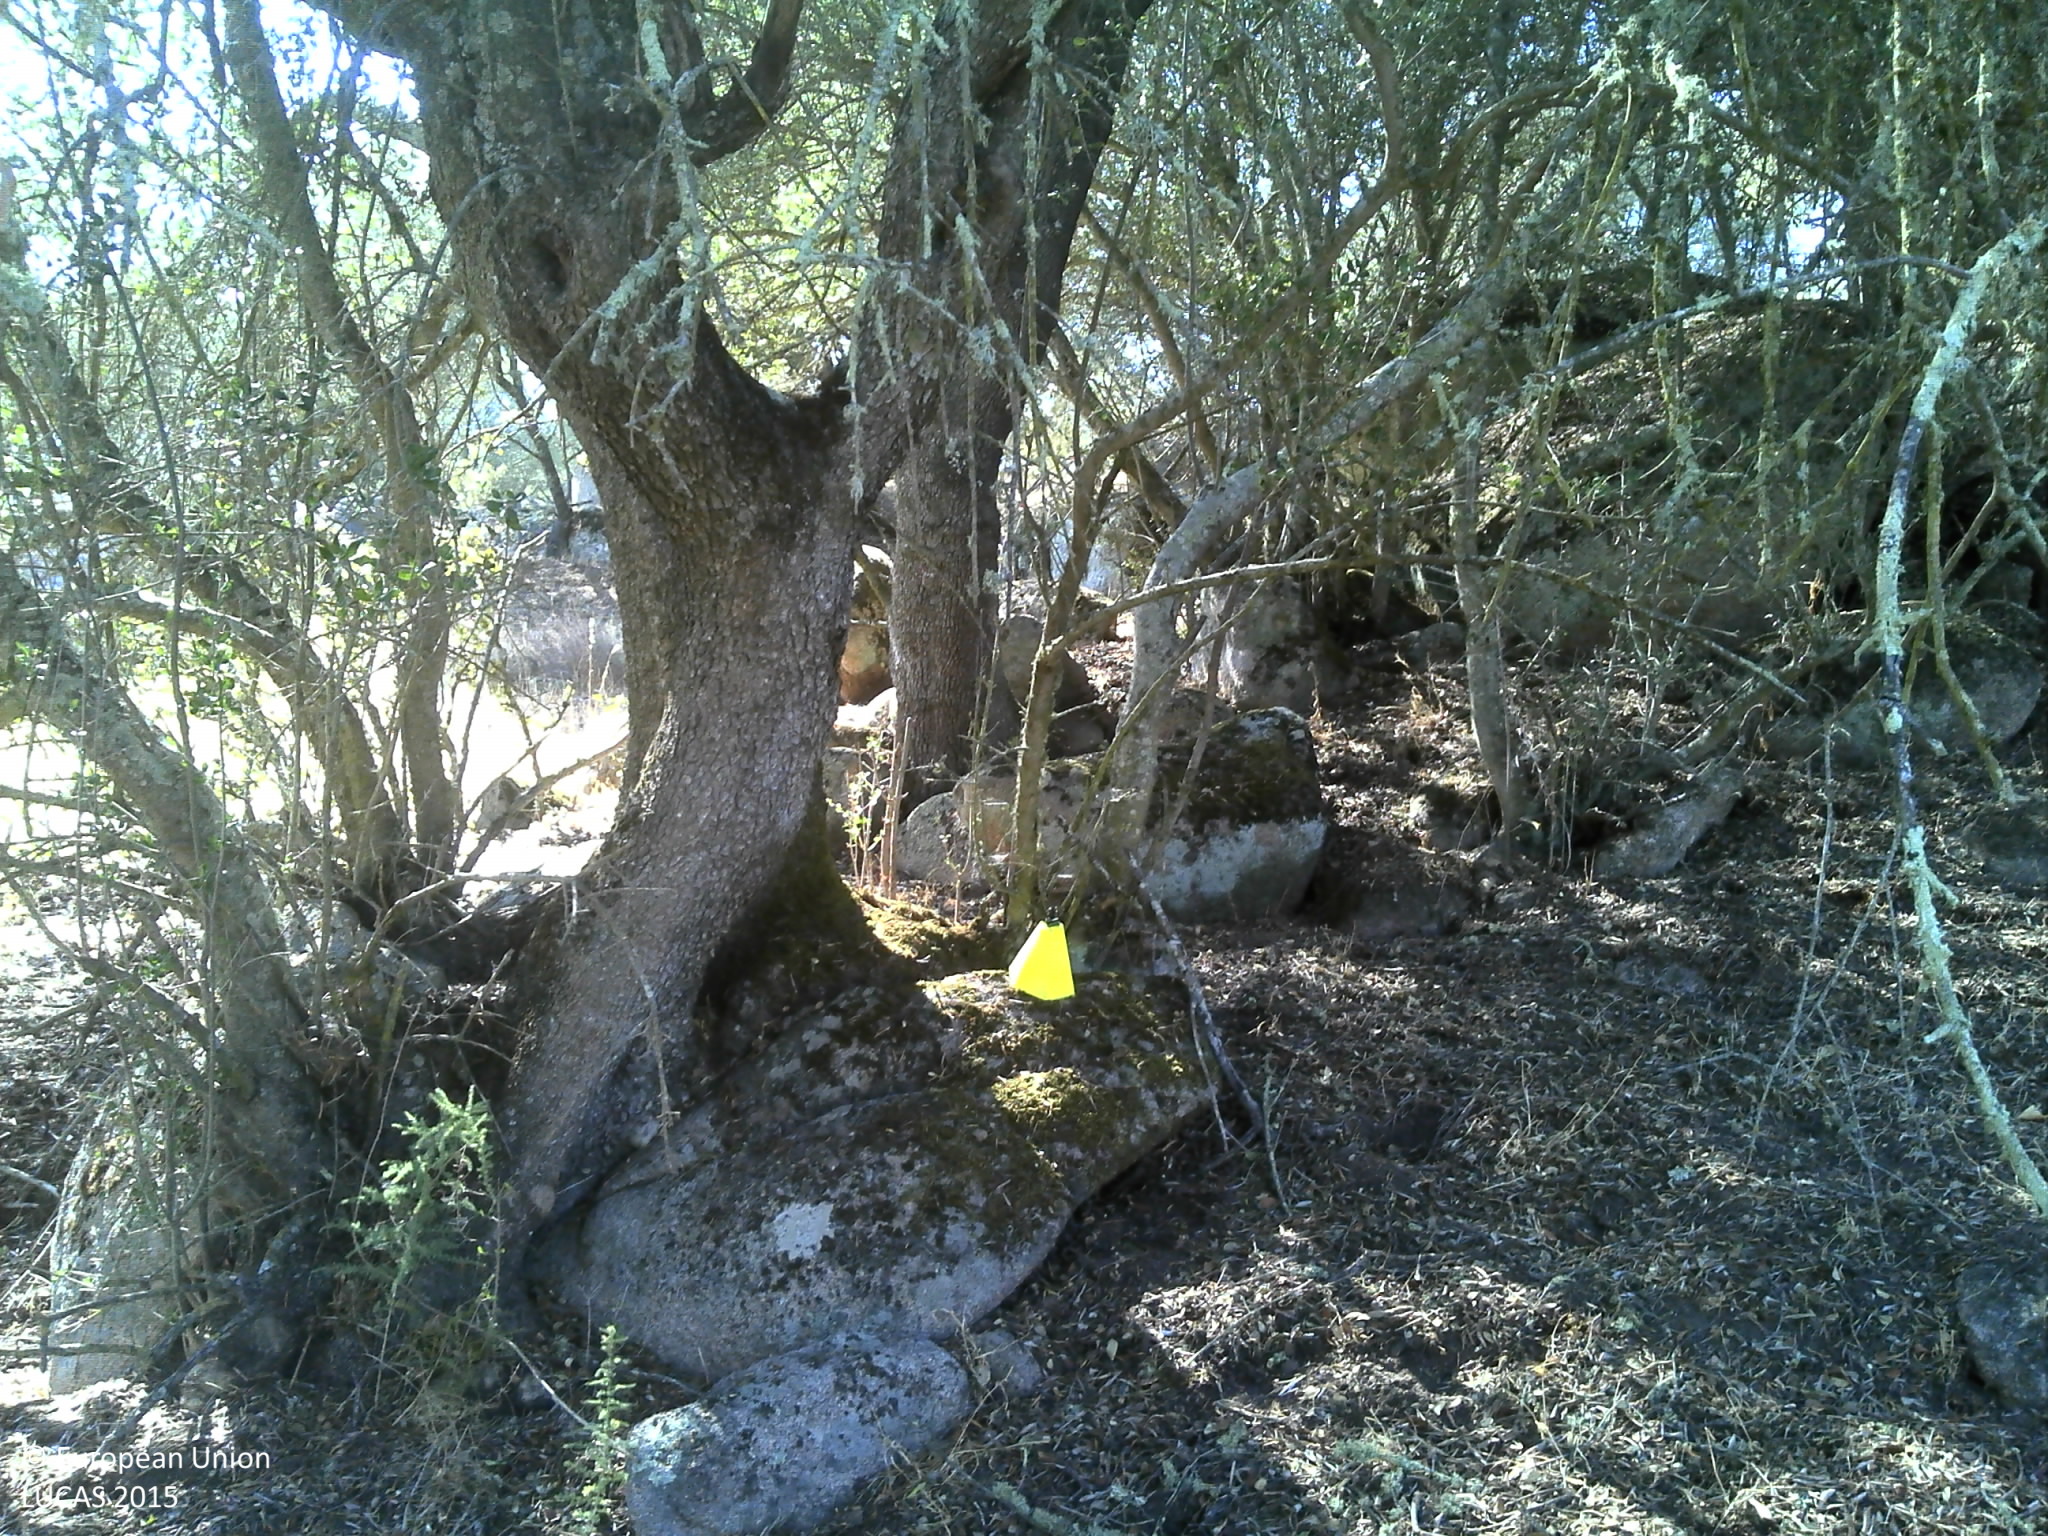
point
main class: Cropland
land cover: Olive groves
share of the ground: 25 - 50 %
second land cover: Shrubland without tree cover
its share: 50 - 75 %
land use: Abandoned areas
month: July
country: PT
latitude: 39.0368
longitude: -7.4708
